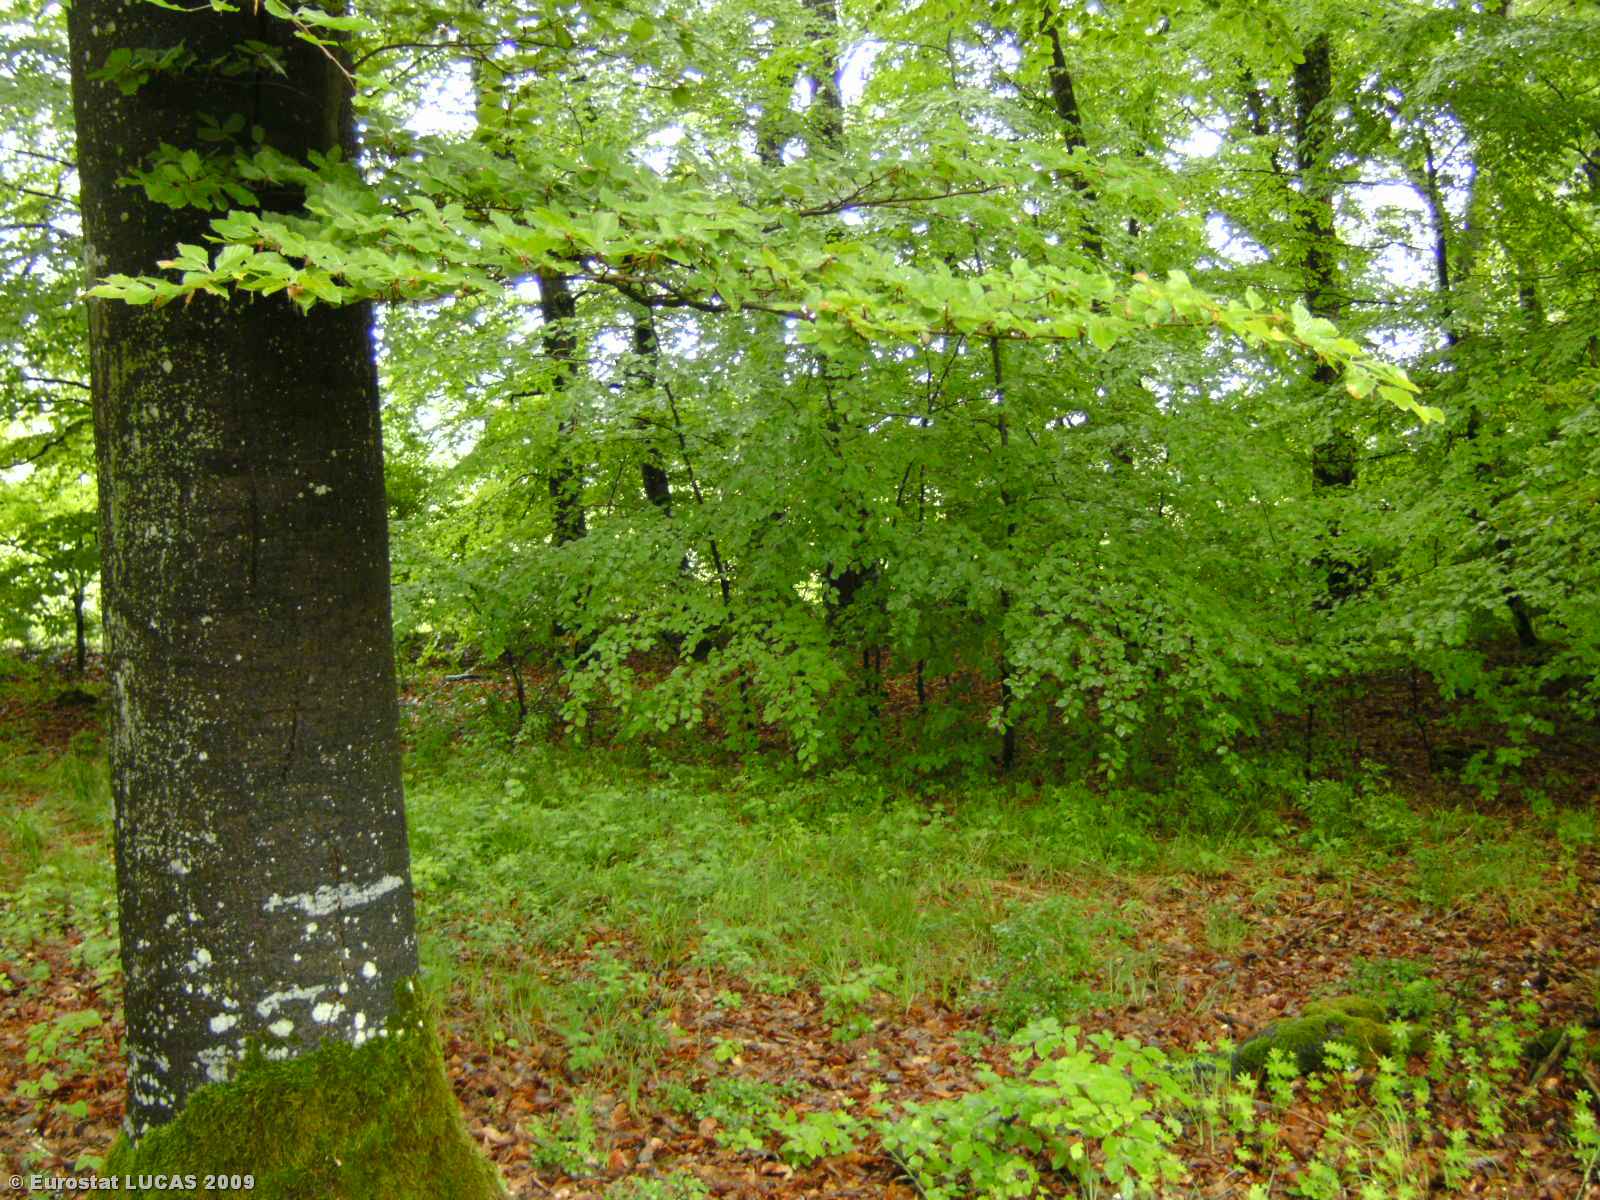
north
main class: Woodland
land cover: Broadleaved woodland
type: beech forest
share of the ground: 50 - 75 %
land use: Forestry
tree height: > 5 m
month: May
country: LU
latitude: 49.8178
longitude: 6.2886
